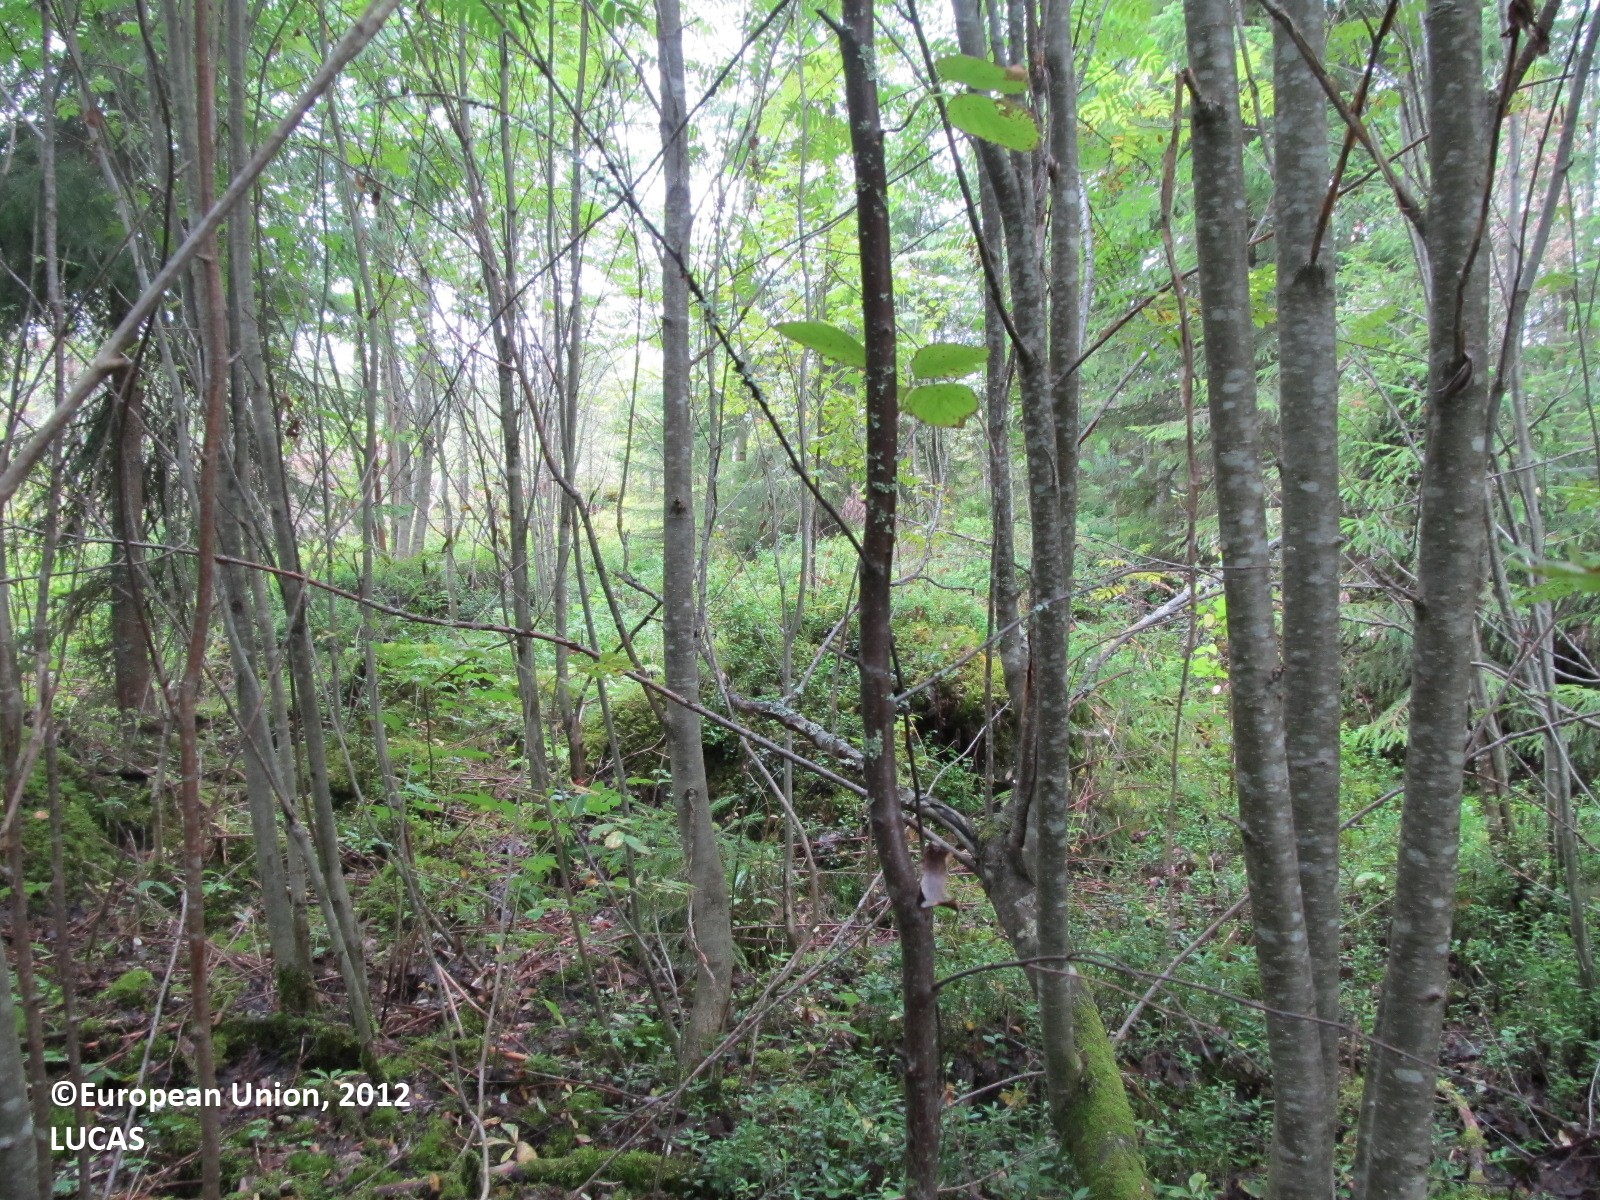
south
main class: Woodland
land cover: Broadleaved woodland
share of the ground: > 75 %
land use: Forestry
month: August
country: FI
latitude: 62.1306
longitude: 27.9625
